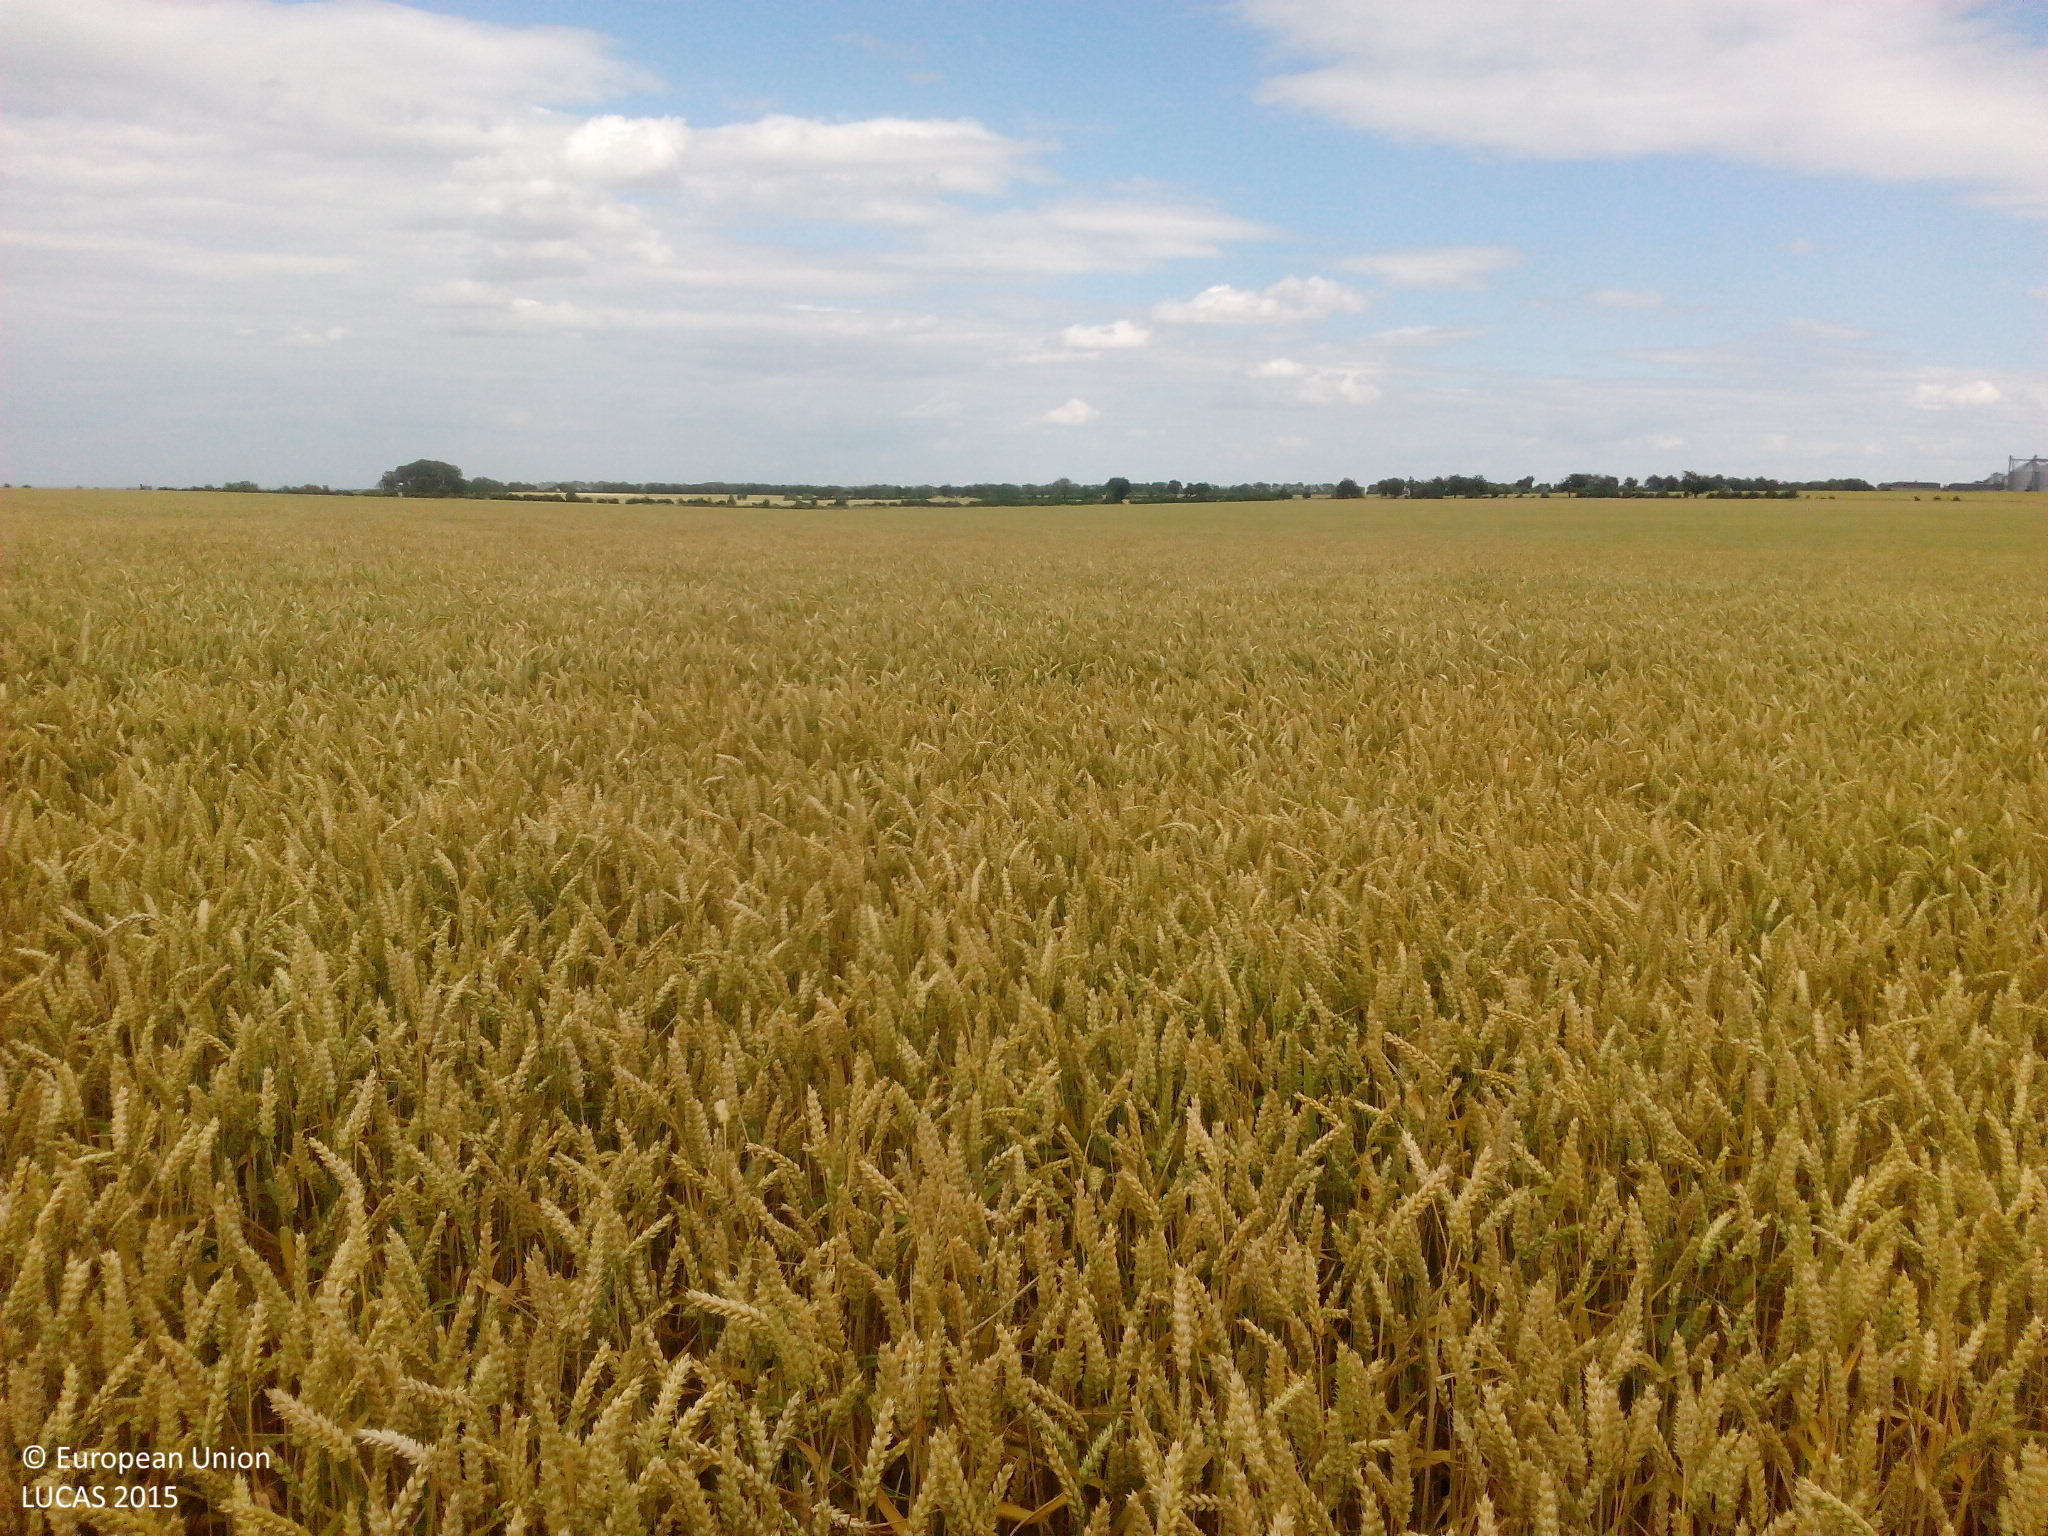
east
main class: Cropland
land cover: Common wheat
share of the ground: > 75 %
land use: Agriculture (excluding fallow land and kitchen gardens)
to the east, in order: Common wheat
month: July
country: DE
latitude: 51.6483
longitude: 11.5460
